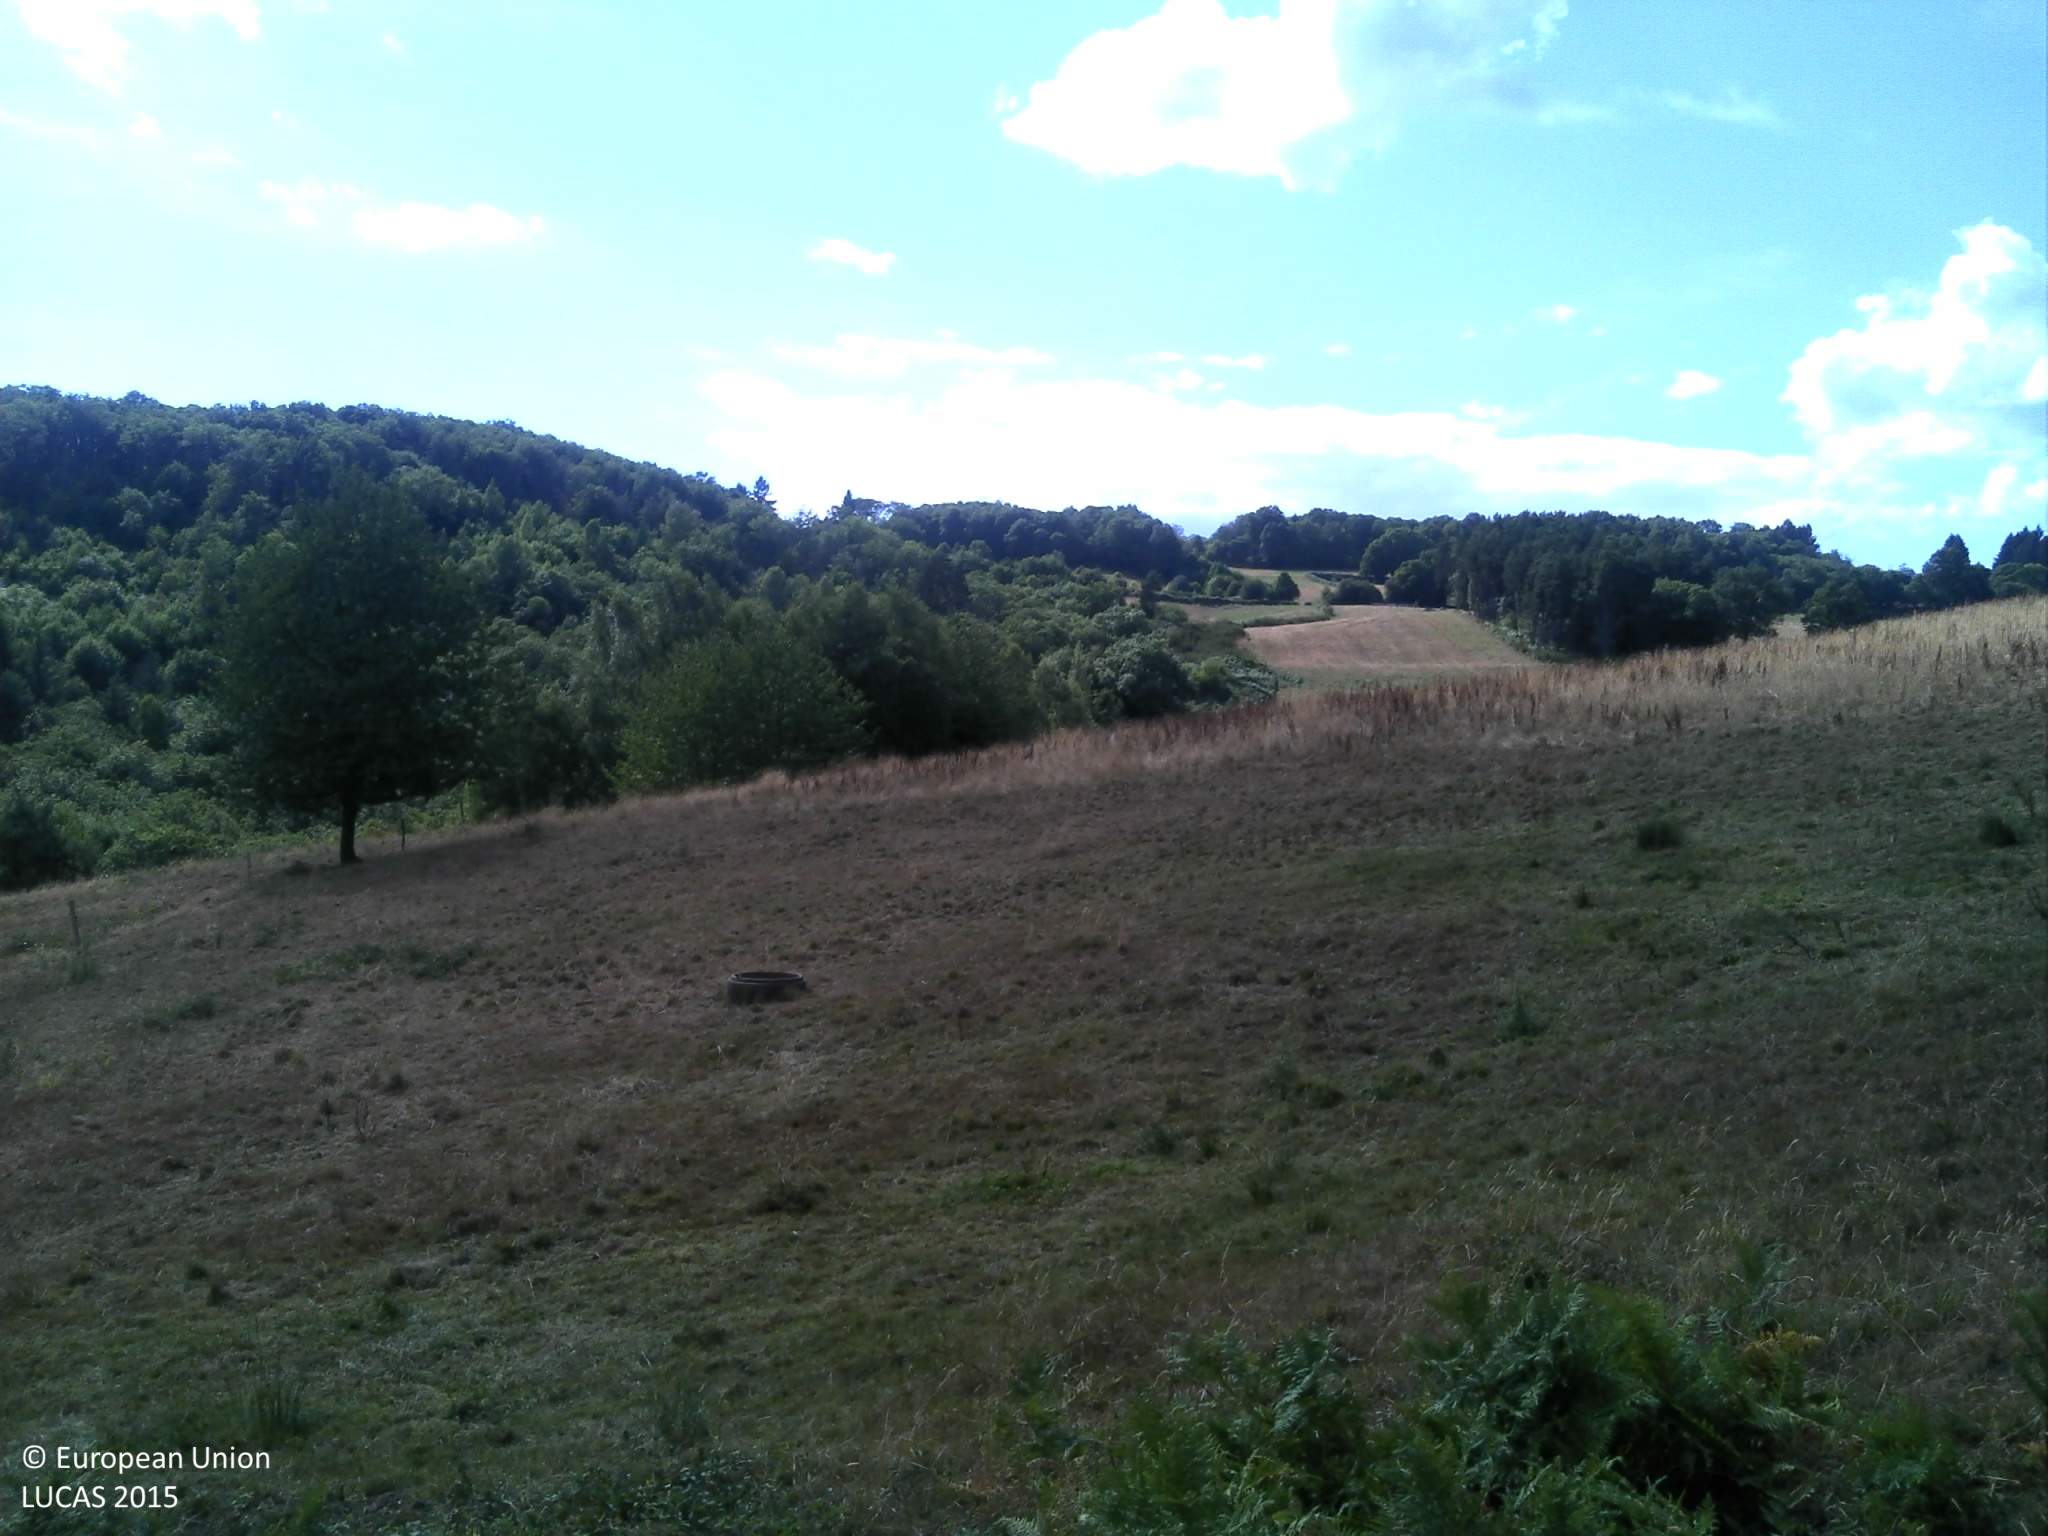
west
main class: Grassland
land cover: Grassland without tree/shrub cover
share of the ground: > 75 %
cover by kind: herbaceous plants 100 %
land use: Agriculture (excluding fallow land and kitchen gardens)
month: July
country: FR
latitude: 45.1423
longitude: 1.7173
